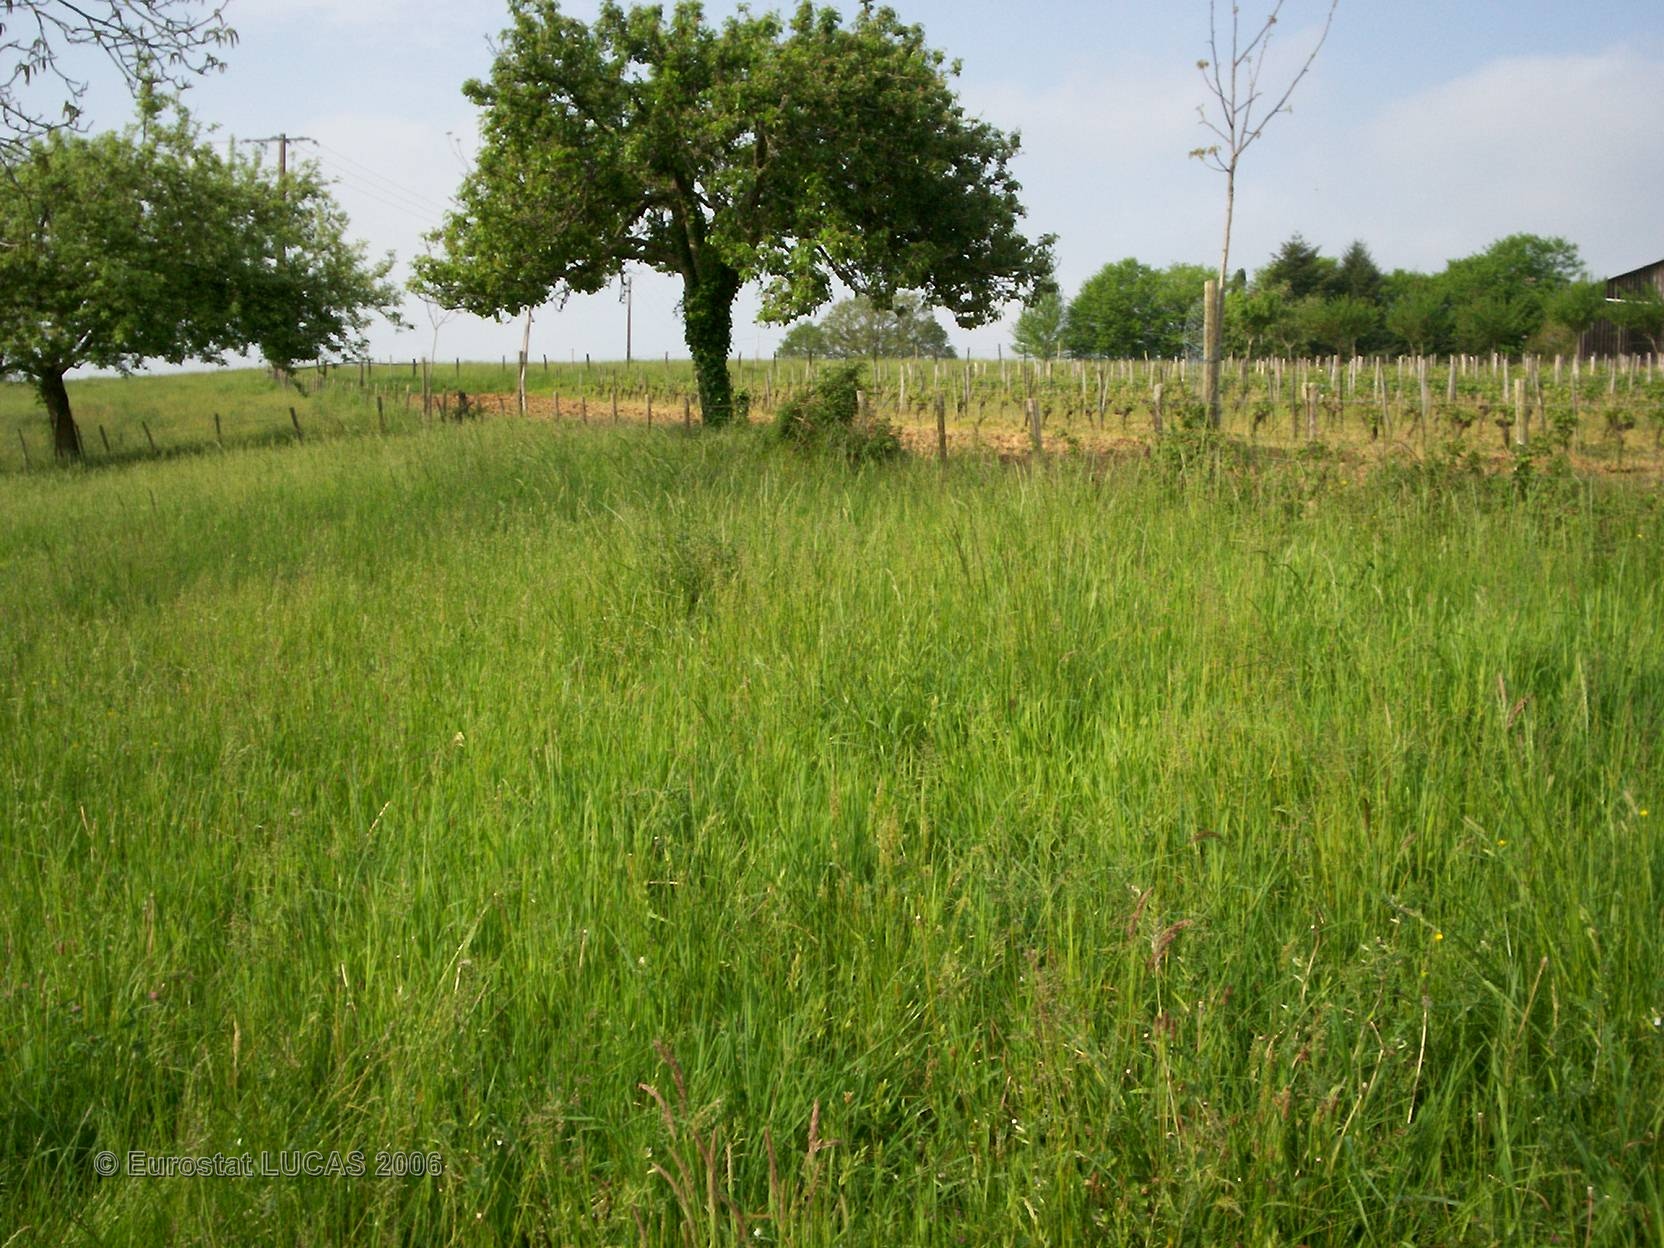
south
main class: Grassland
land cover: Grassland with sparse tree/shrub cover
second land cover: Nuts trees
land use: Agriculture (excluding fallow land and kitchen gardens)
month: May
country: FR
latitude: 45.2317
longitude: 0.8326
